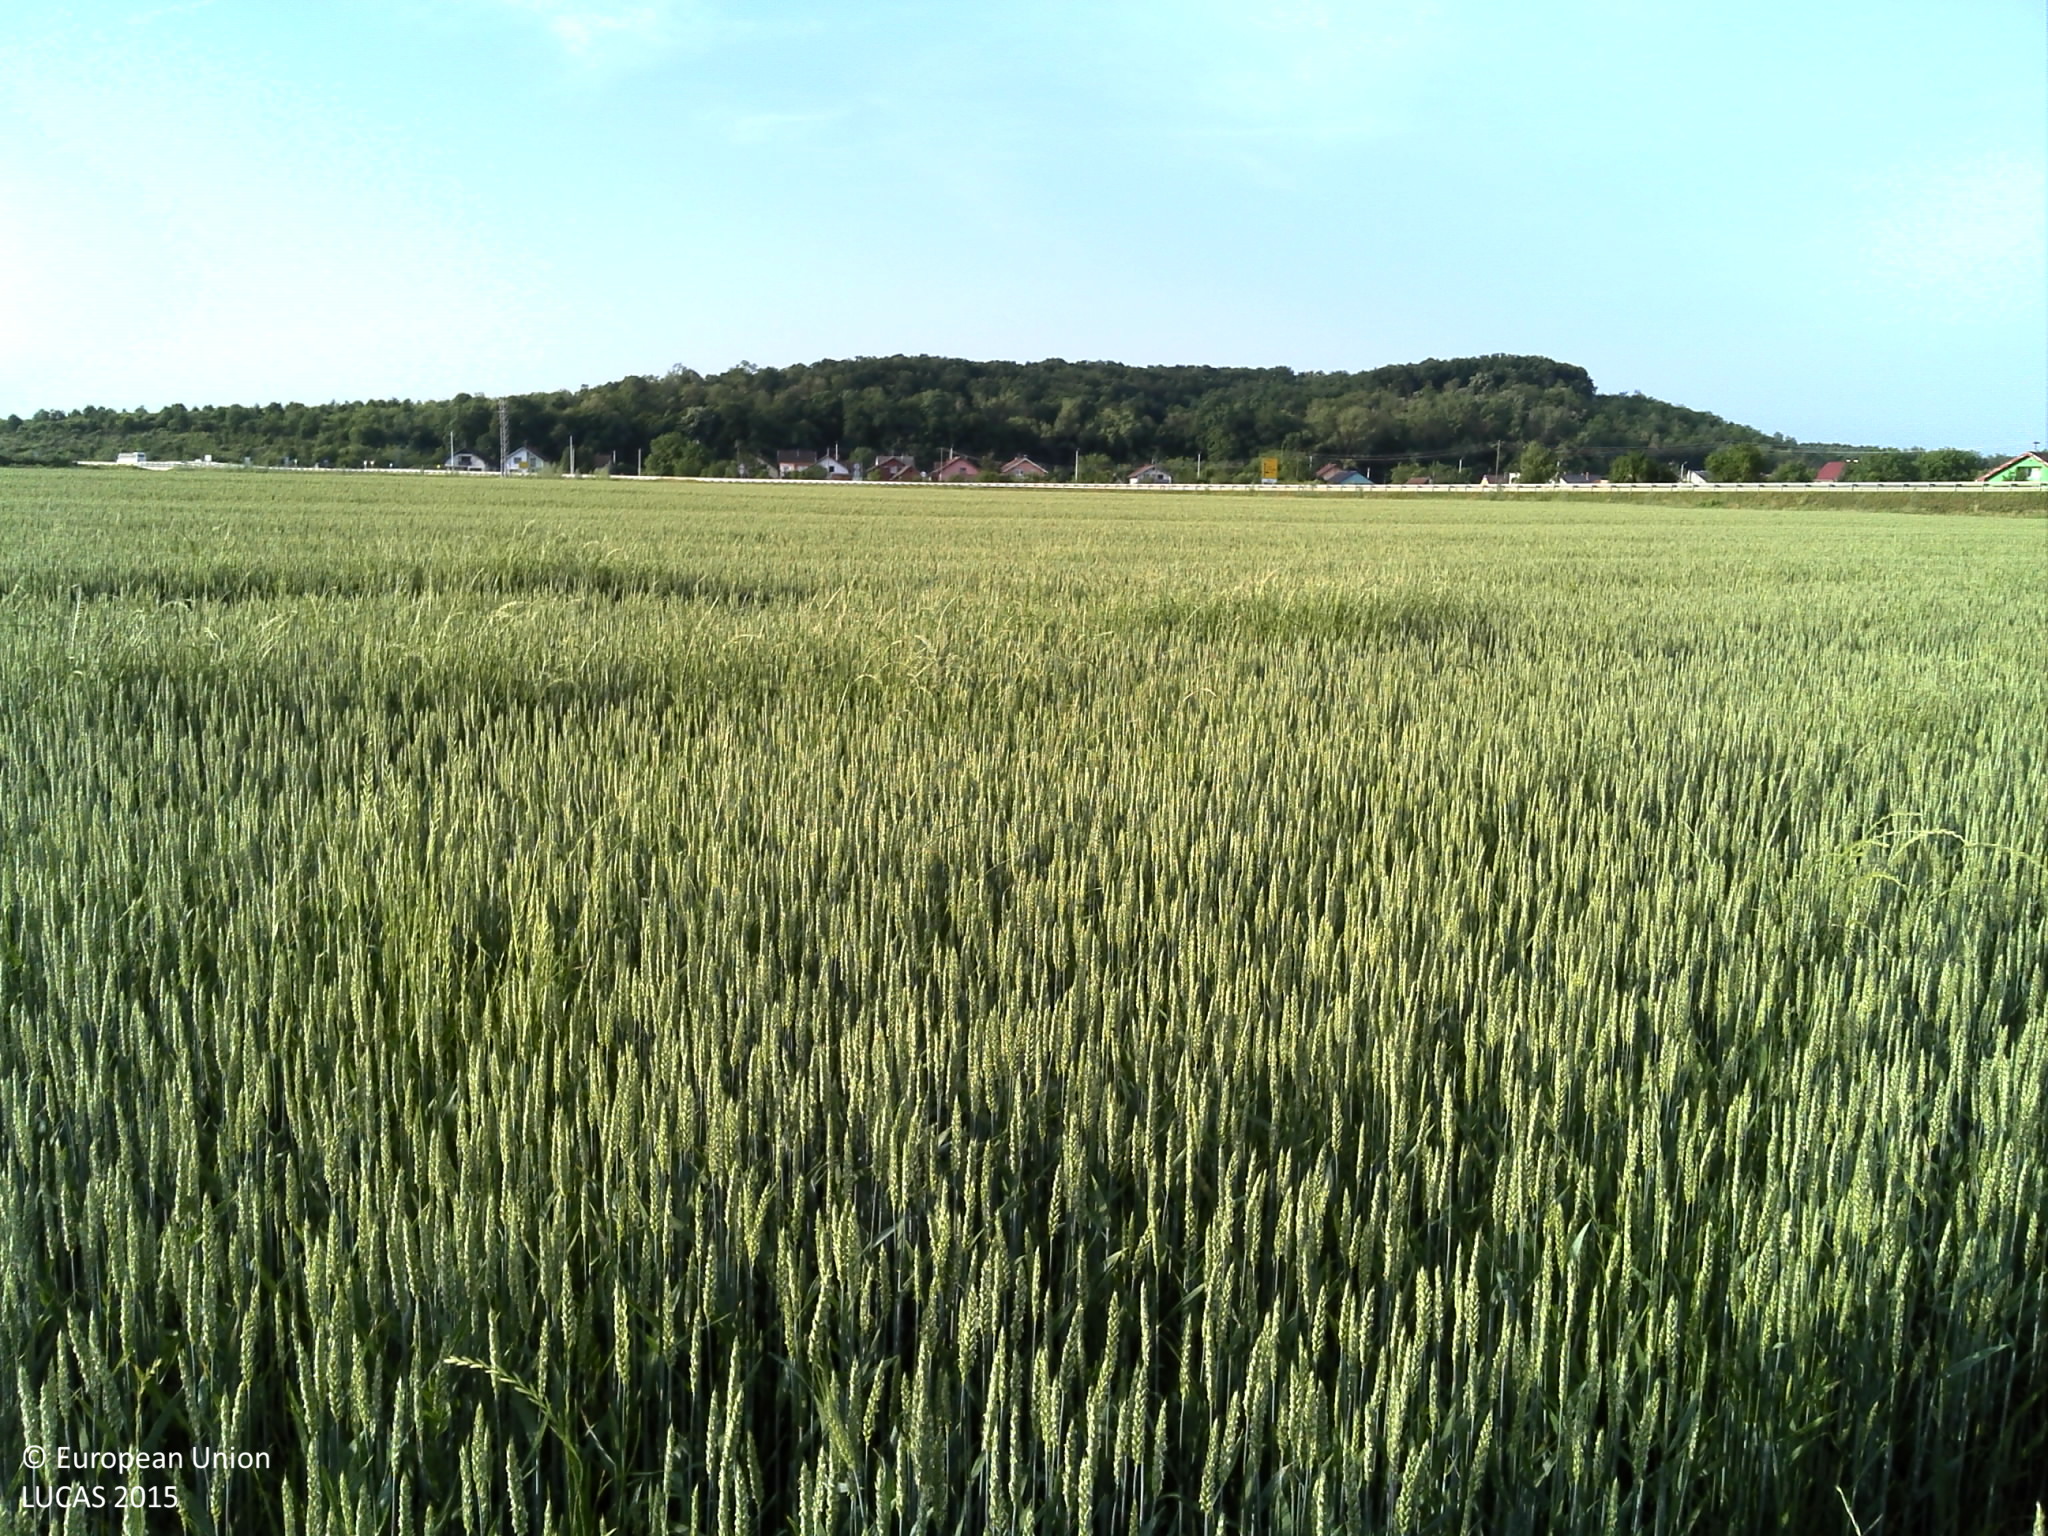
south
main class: Cropland
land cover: Common wheat
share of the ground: > 75 %
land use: Agriculture (excluding fallow land and kitchen gardens)
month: May
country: HR
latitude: 45.4983
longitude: 18.1306
